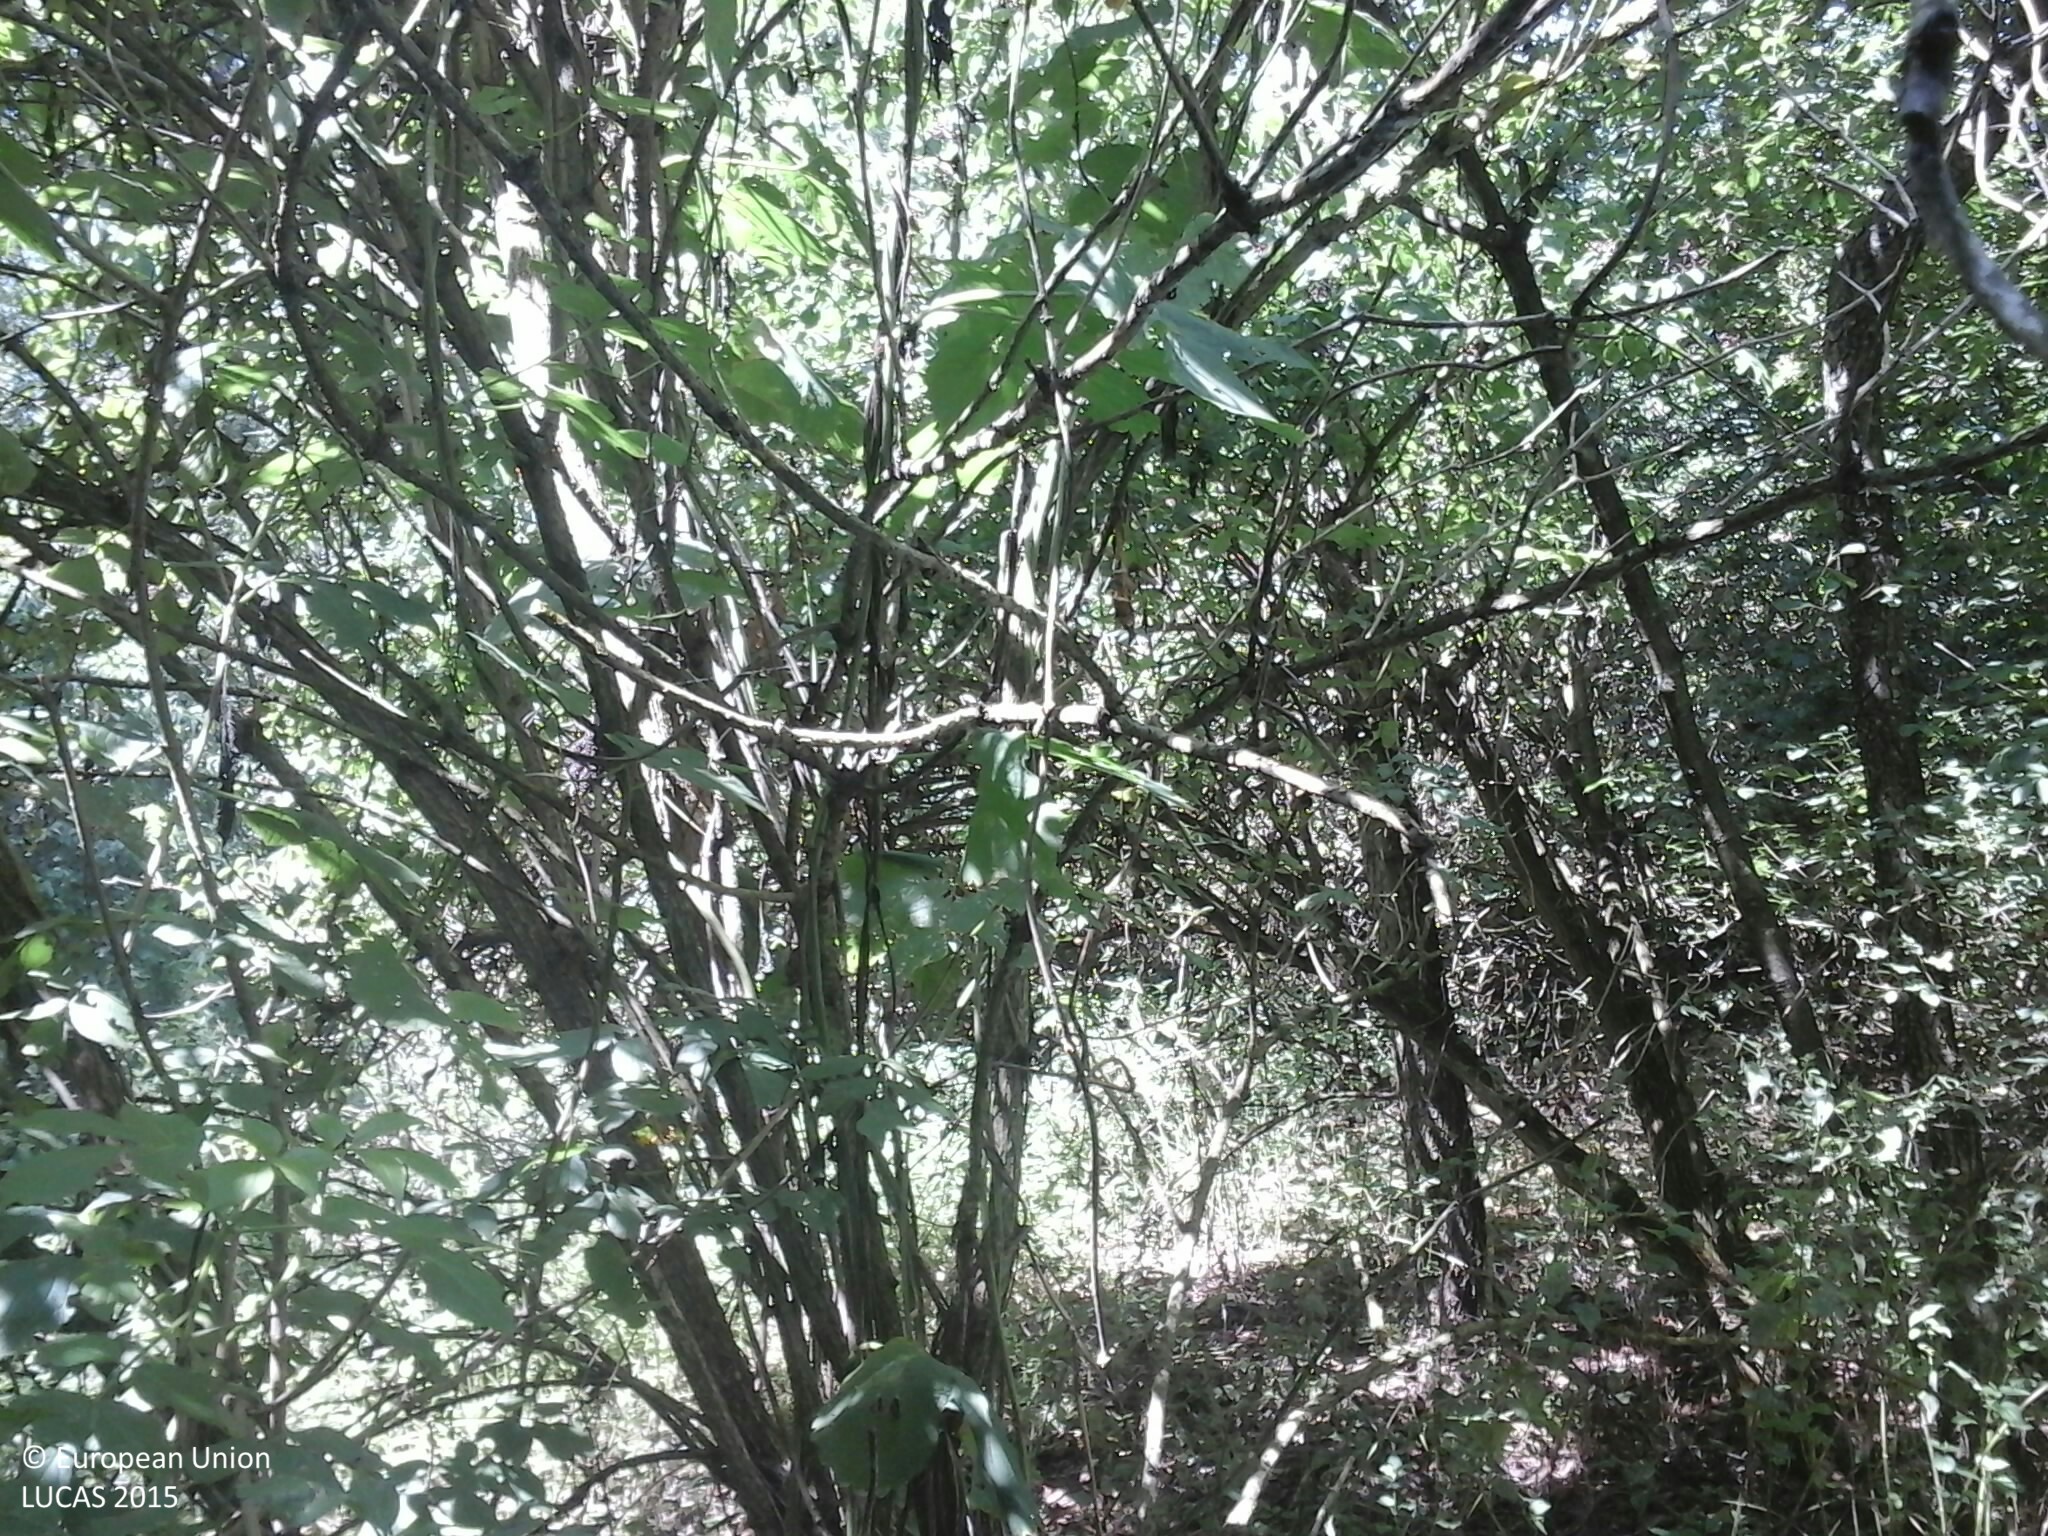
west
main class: Woodland
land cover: Broadleaved woodland
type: mesophytic deciduous forest
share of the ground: > 75 %
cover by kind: broadleaved forest trees 90 %, herbaceous plants 10 %
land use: Forestry
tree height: > 5 m
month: August
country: HU
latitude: 46.5927
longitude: 17.7728
